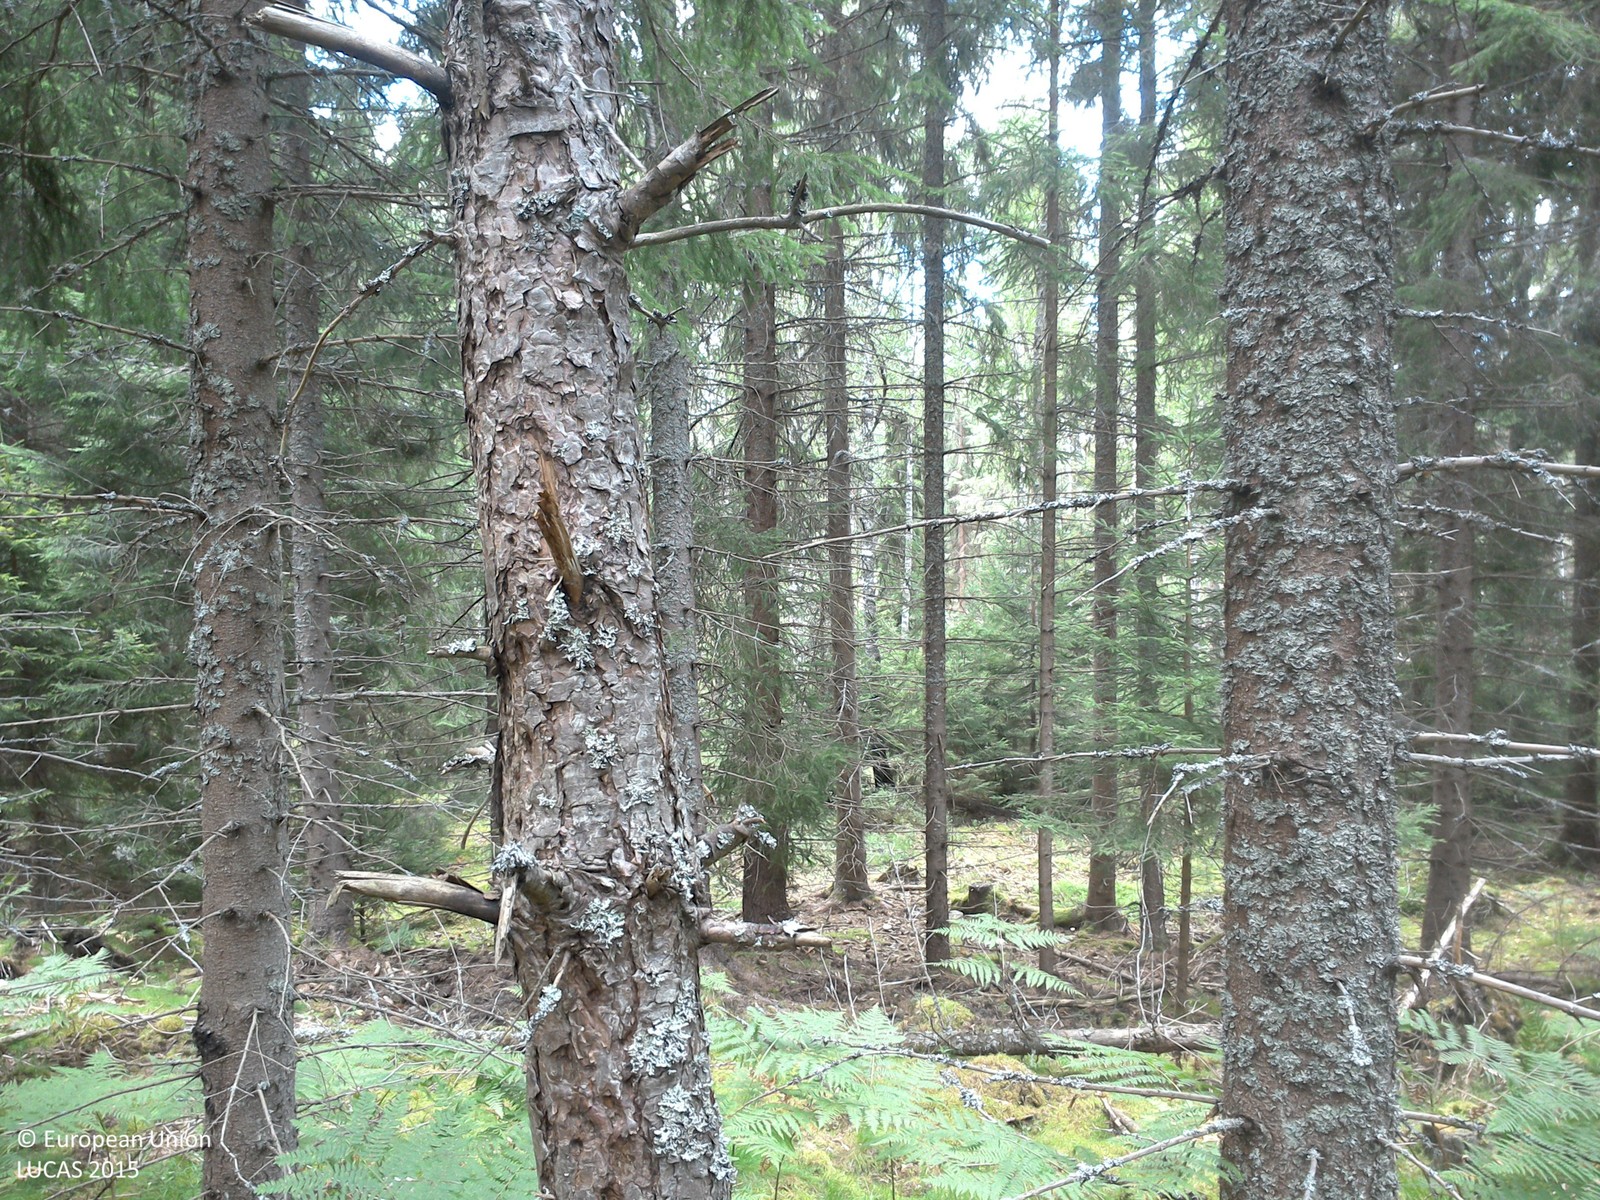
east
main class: Woodland
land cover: Spruce dominated coniferous woodland
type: boreal forest
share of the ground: 50 - 75 %
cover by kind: coniferous forest trees 60 %, herbaceous plants 30 %, lichens and mosses 10 %
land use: Forestry
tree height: > 5 m
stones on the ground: < 10 %
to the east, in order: Spruce dominated coniferous woodland; Spruce dominated mixed woodland; Spruce dominated coniferous woodland; Spruce dominated mixed woodland; Ditches and canals; Spruce dominated coniferous woodland
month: August
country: SE
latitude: 57.8888
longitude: 15.5451
